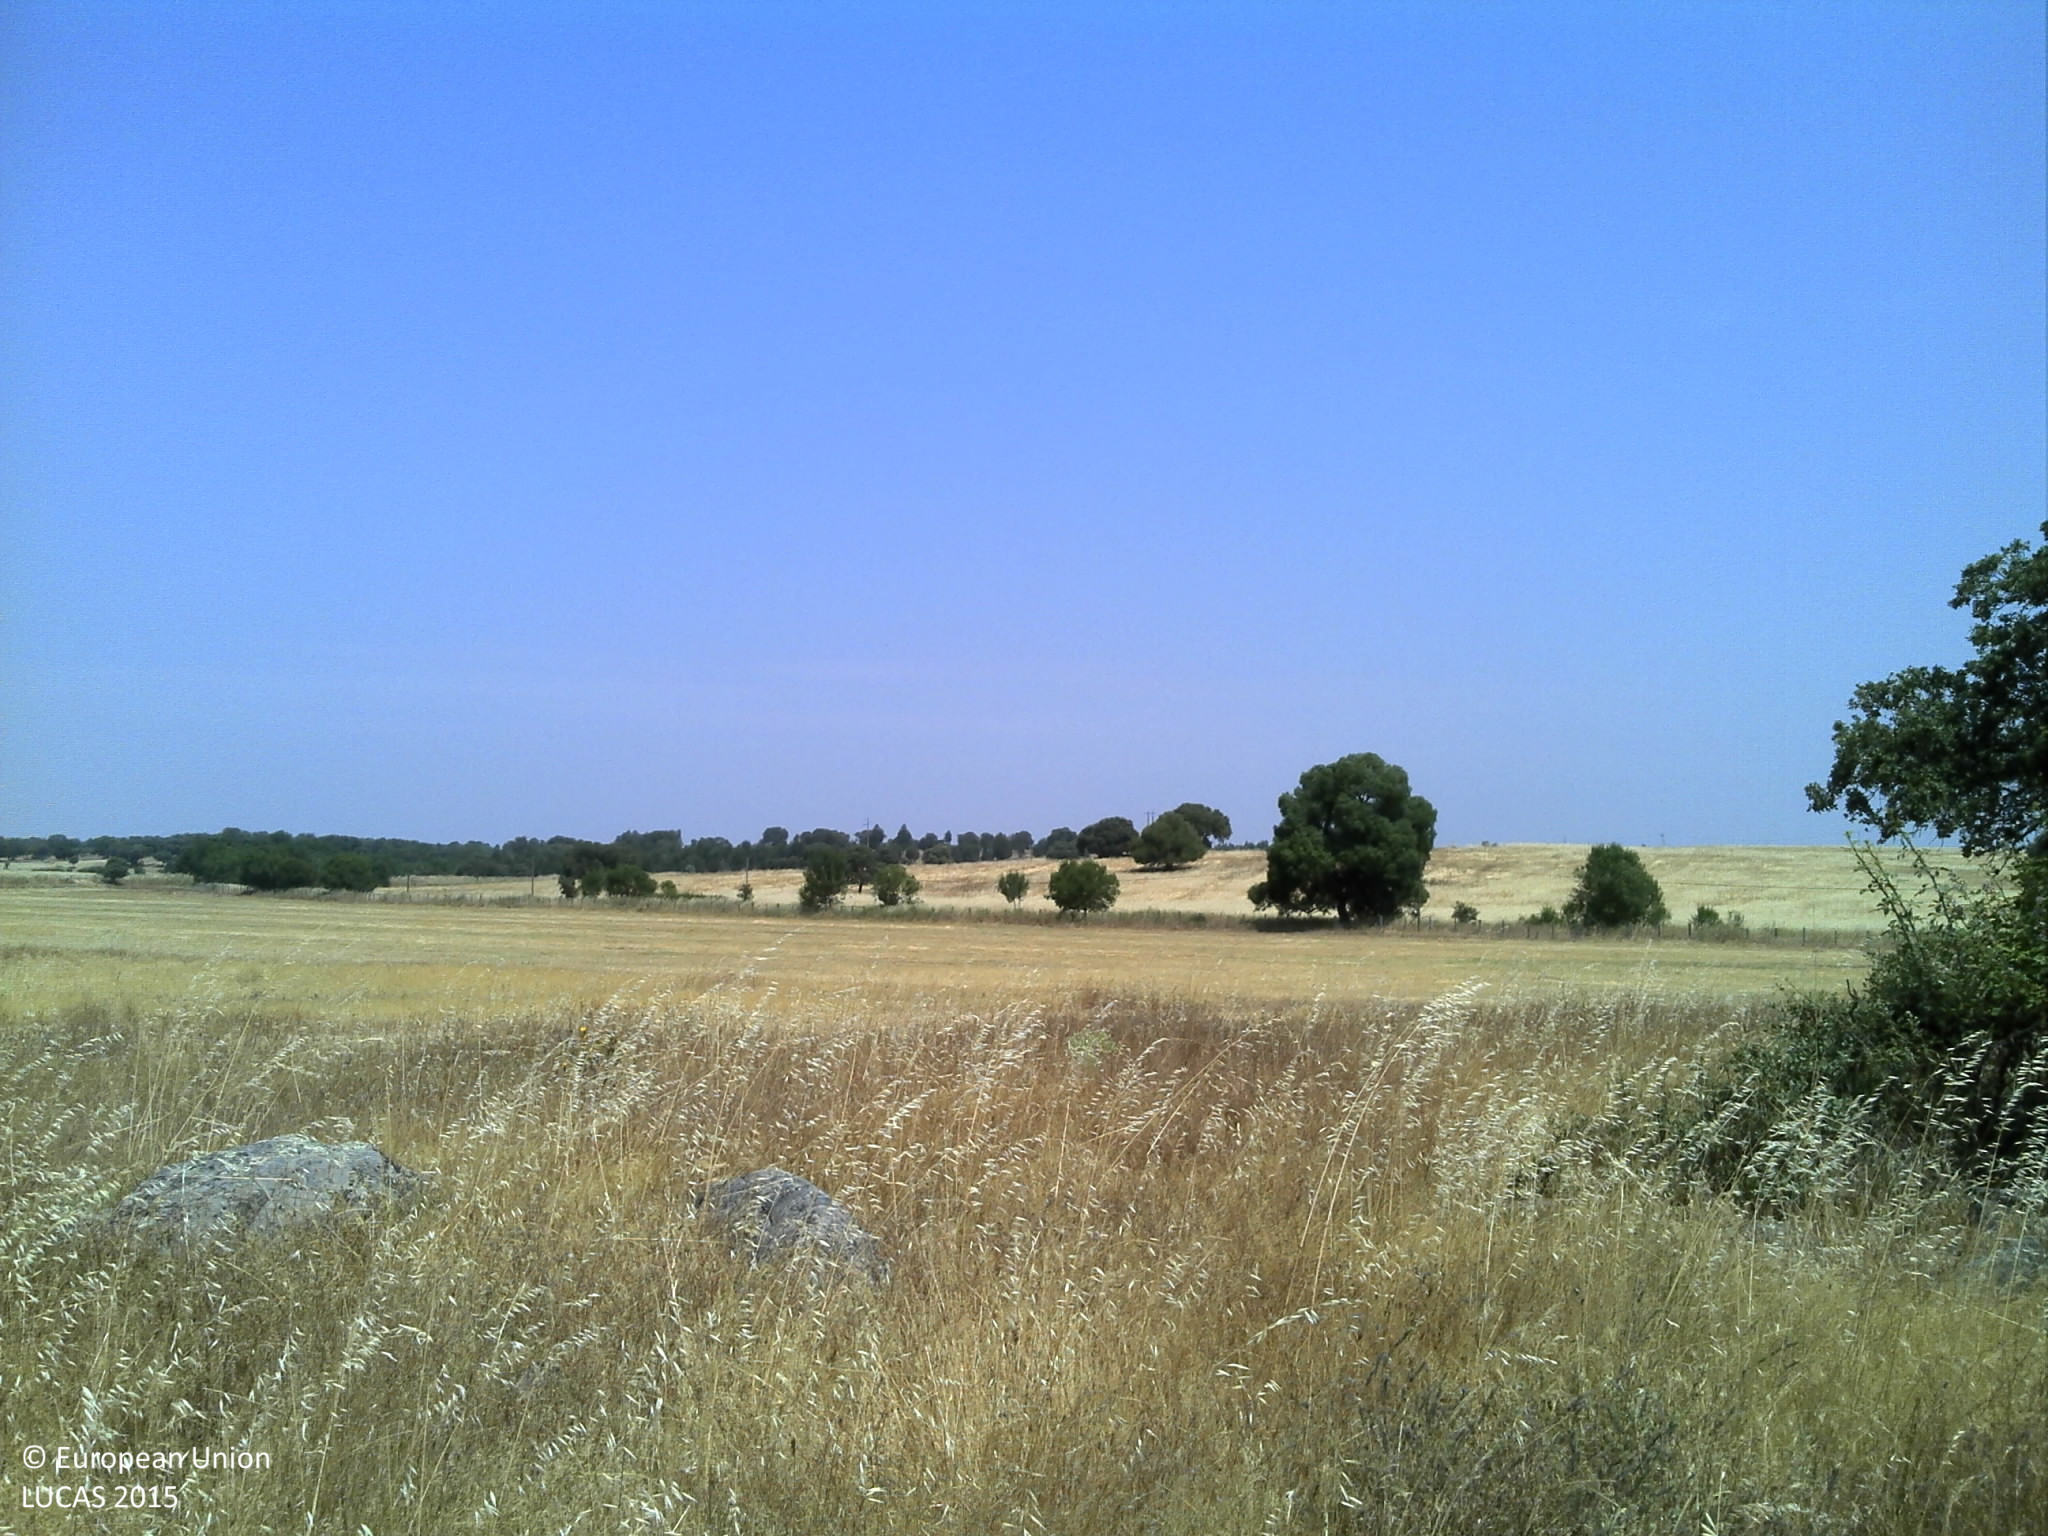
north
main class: Grassland
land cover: Grassland without tree/shrub cover
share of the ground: > 75 %
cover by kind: herbaceous plants 75 %, unconsolidated bare surface 25 %
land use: Agriculture (excluding fallow land and kitchen gardens)
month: June
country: PT
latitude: 38.4919
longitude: -7.8182
